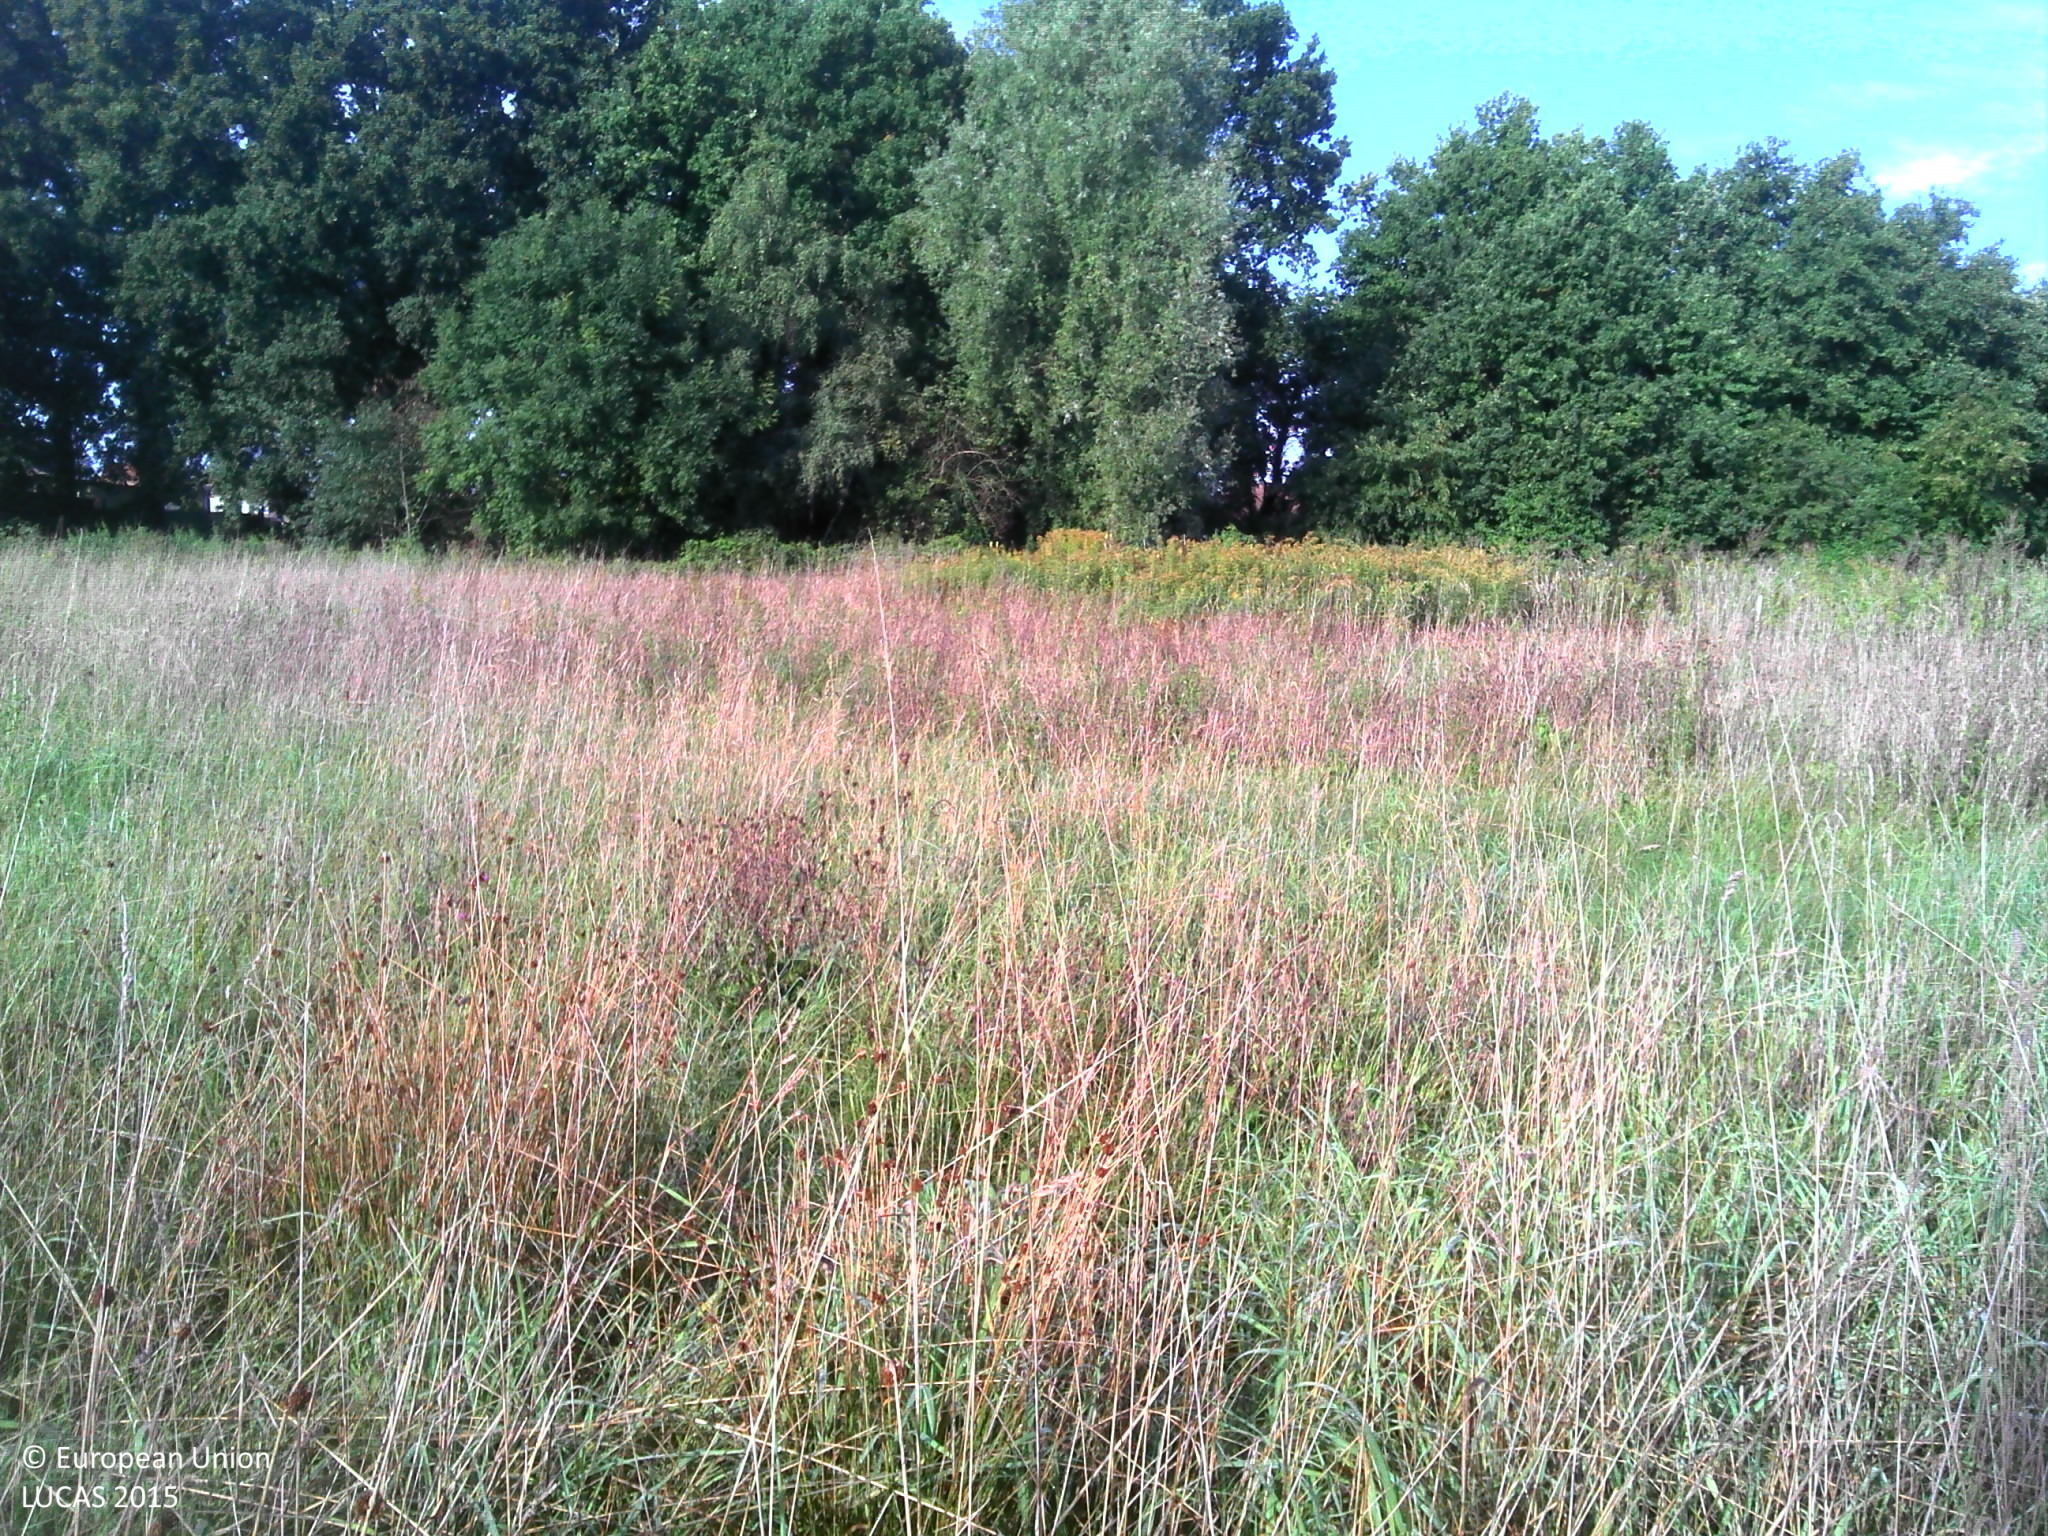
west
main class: Grassland
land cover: Grassland without tree/shrub cover
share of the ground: > 75 %
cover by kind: herbaceous plants 100 %
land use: Semi-natural and natural areas not in use
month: September
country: BE
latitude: 51.1585
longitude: 4.6628
